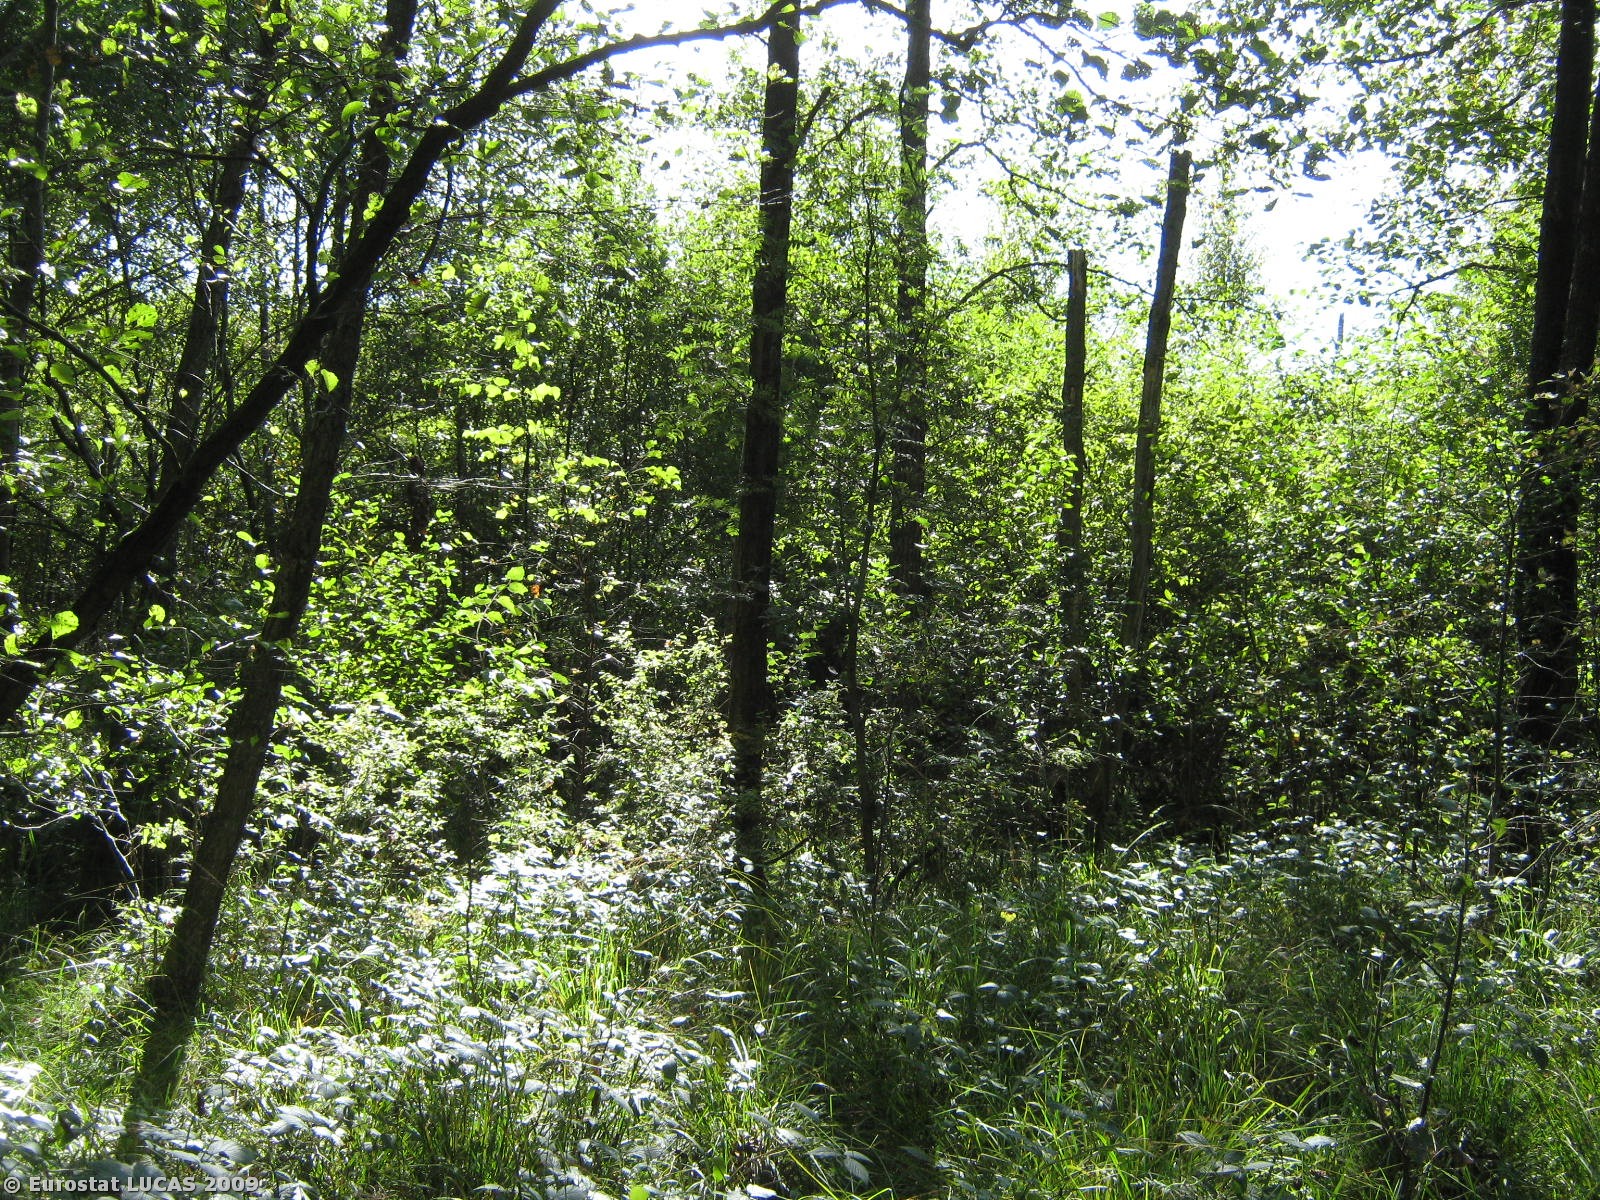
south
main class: Woodland
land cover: Broadleaved woodland
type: hemiboreal forest and nemoral coniferous forest and mixed broadleaved-coniferous forest
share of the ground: > 75 %
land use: Forestry
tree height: > 5 m
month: September
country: PL
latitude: 53.9091
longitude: 16.5676
